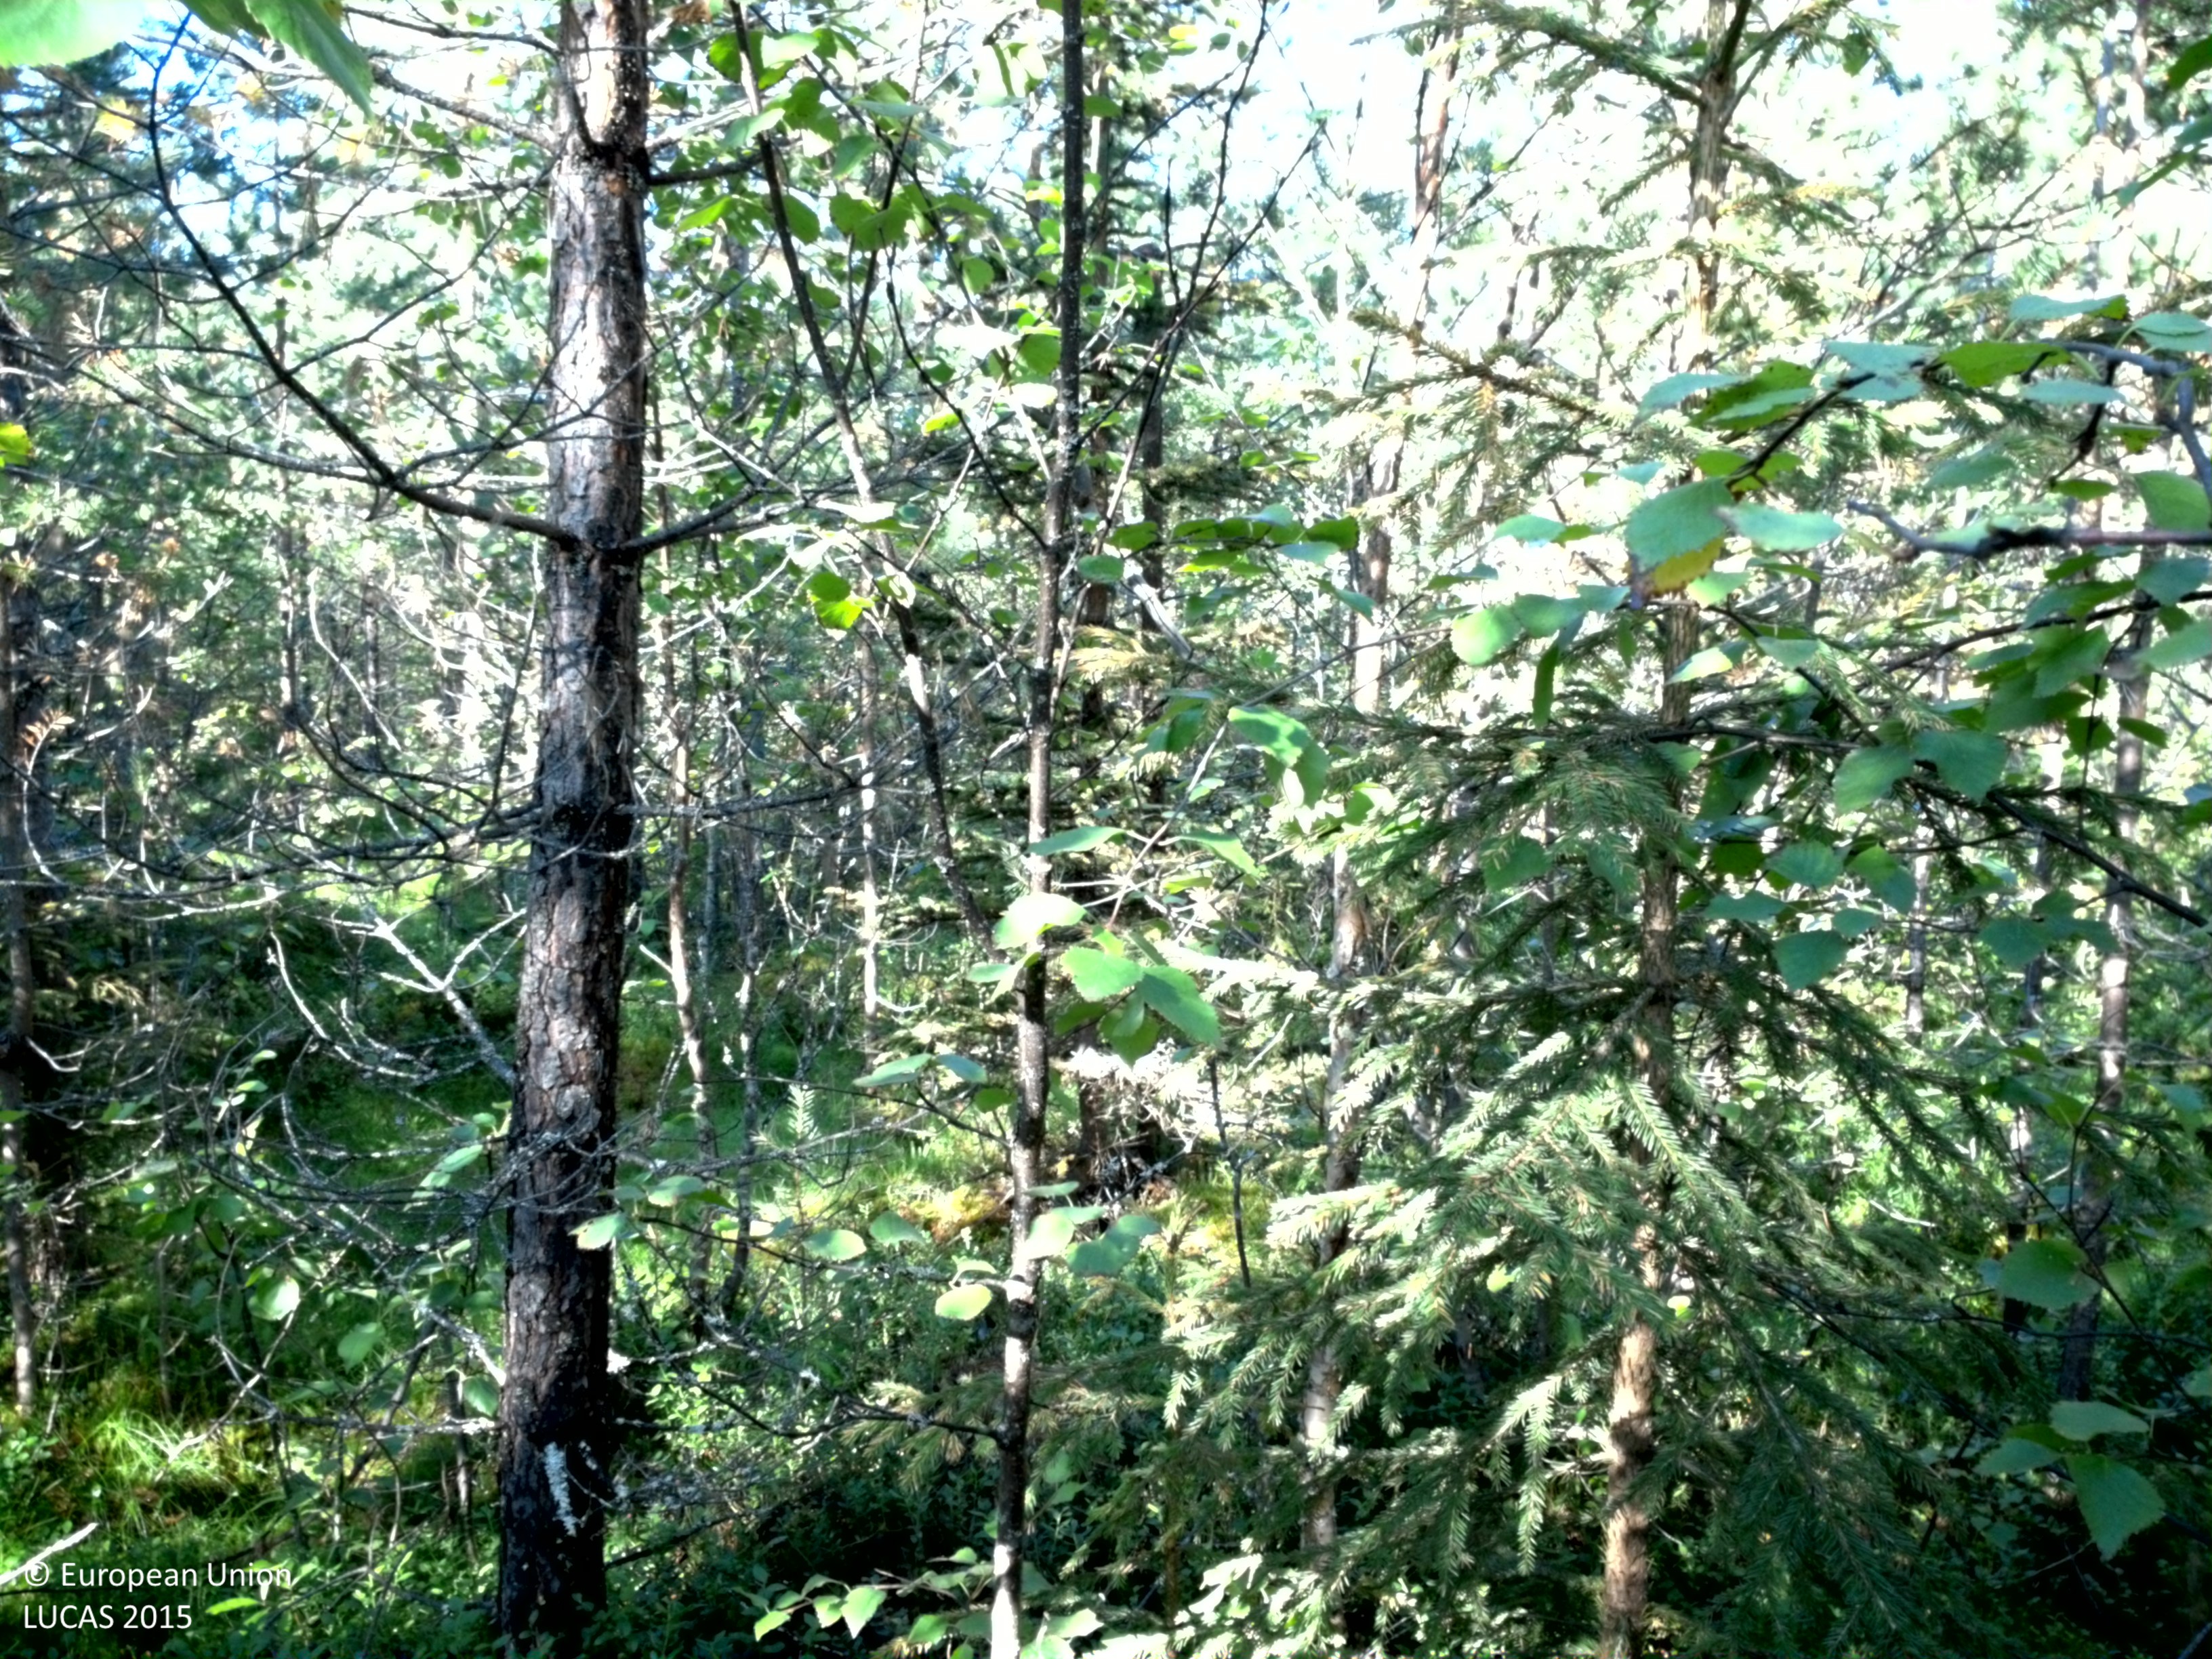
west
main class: Woodland
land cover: Pine dominated mixed woodland
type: boreal forest
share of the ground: 50 - 75 %
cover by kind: broadleaved forest trees 35 %, coniferous forest trees 30 %, shrubs 30 %, lichens and mosses 5 %
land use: Forestry
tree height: > 5 m
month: August
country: SE
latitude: 66.0636
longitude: 22.5462
